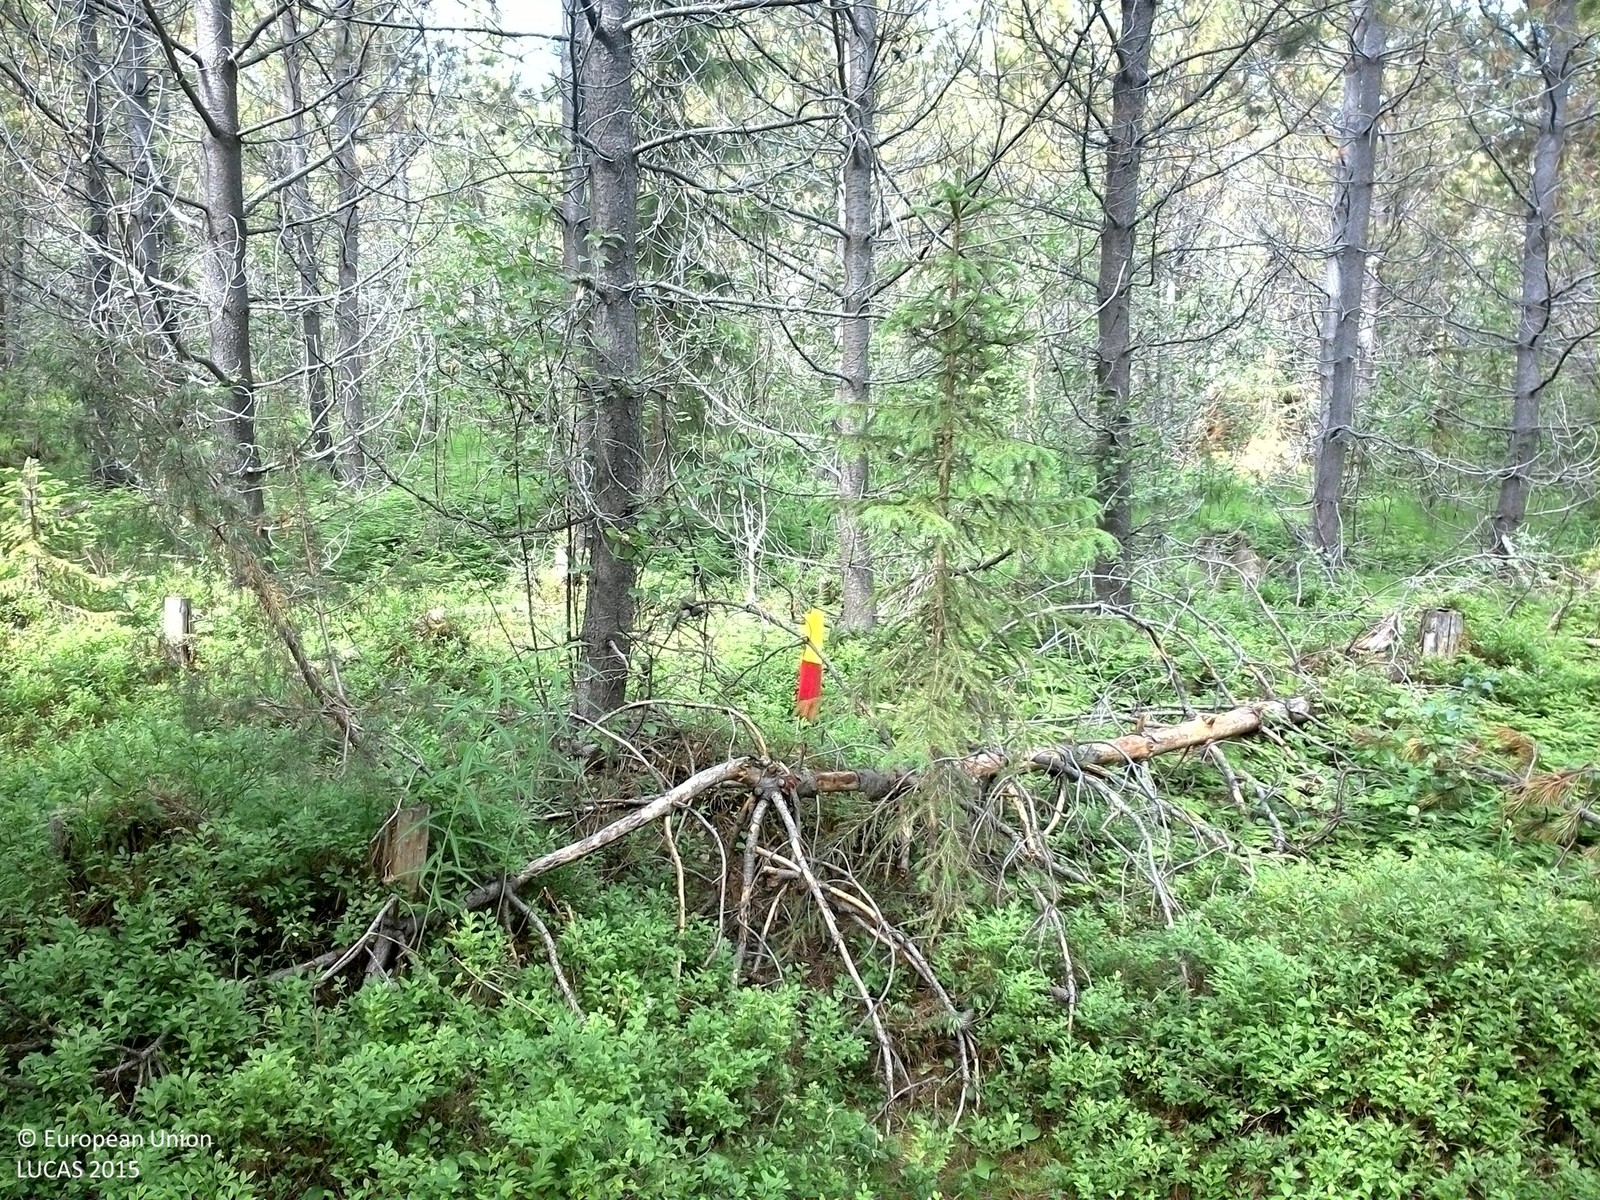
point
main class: Woodland
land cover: Pine dominated coniferous woodland
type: exotic forest
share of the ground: 50 - 75 %
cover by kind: coniferous forest trees 55 %, shrubs 15 %, broadleaved forest trees 10 %, herbaceous plants 10 %, lichens and mosses 10 %
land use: Forestry
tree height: > 5 m
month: July
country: SE
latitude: 64.6131
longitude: 15.4259
